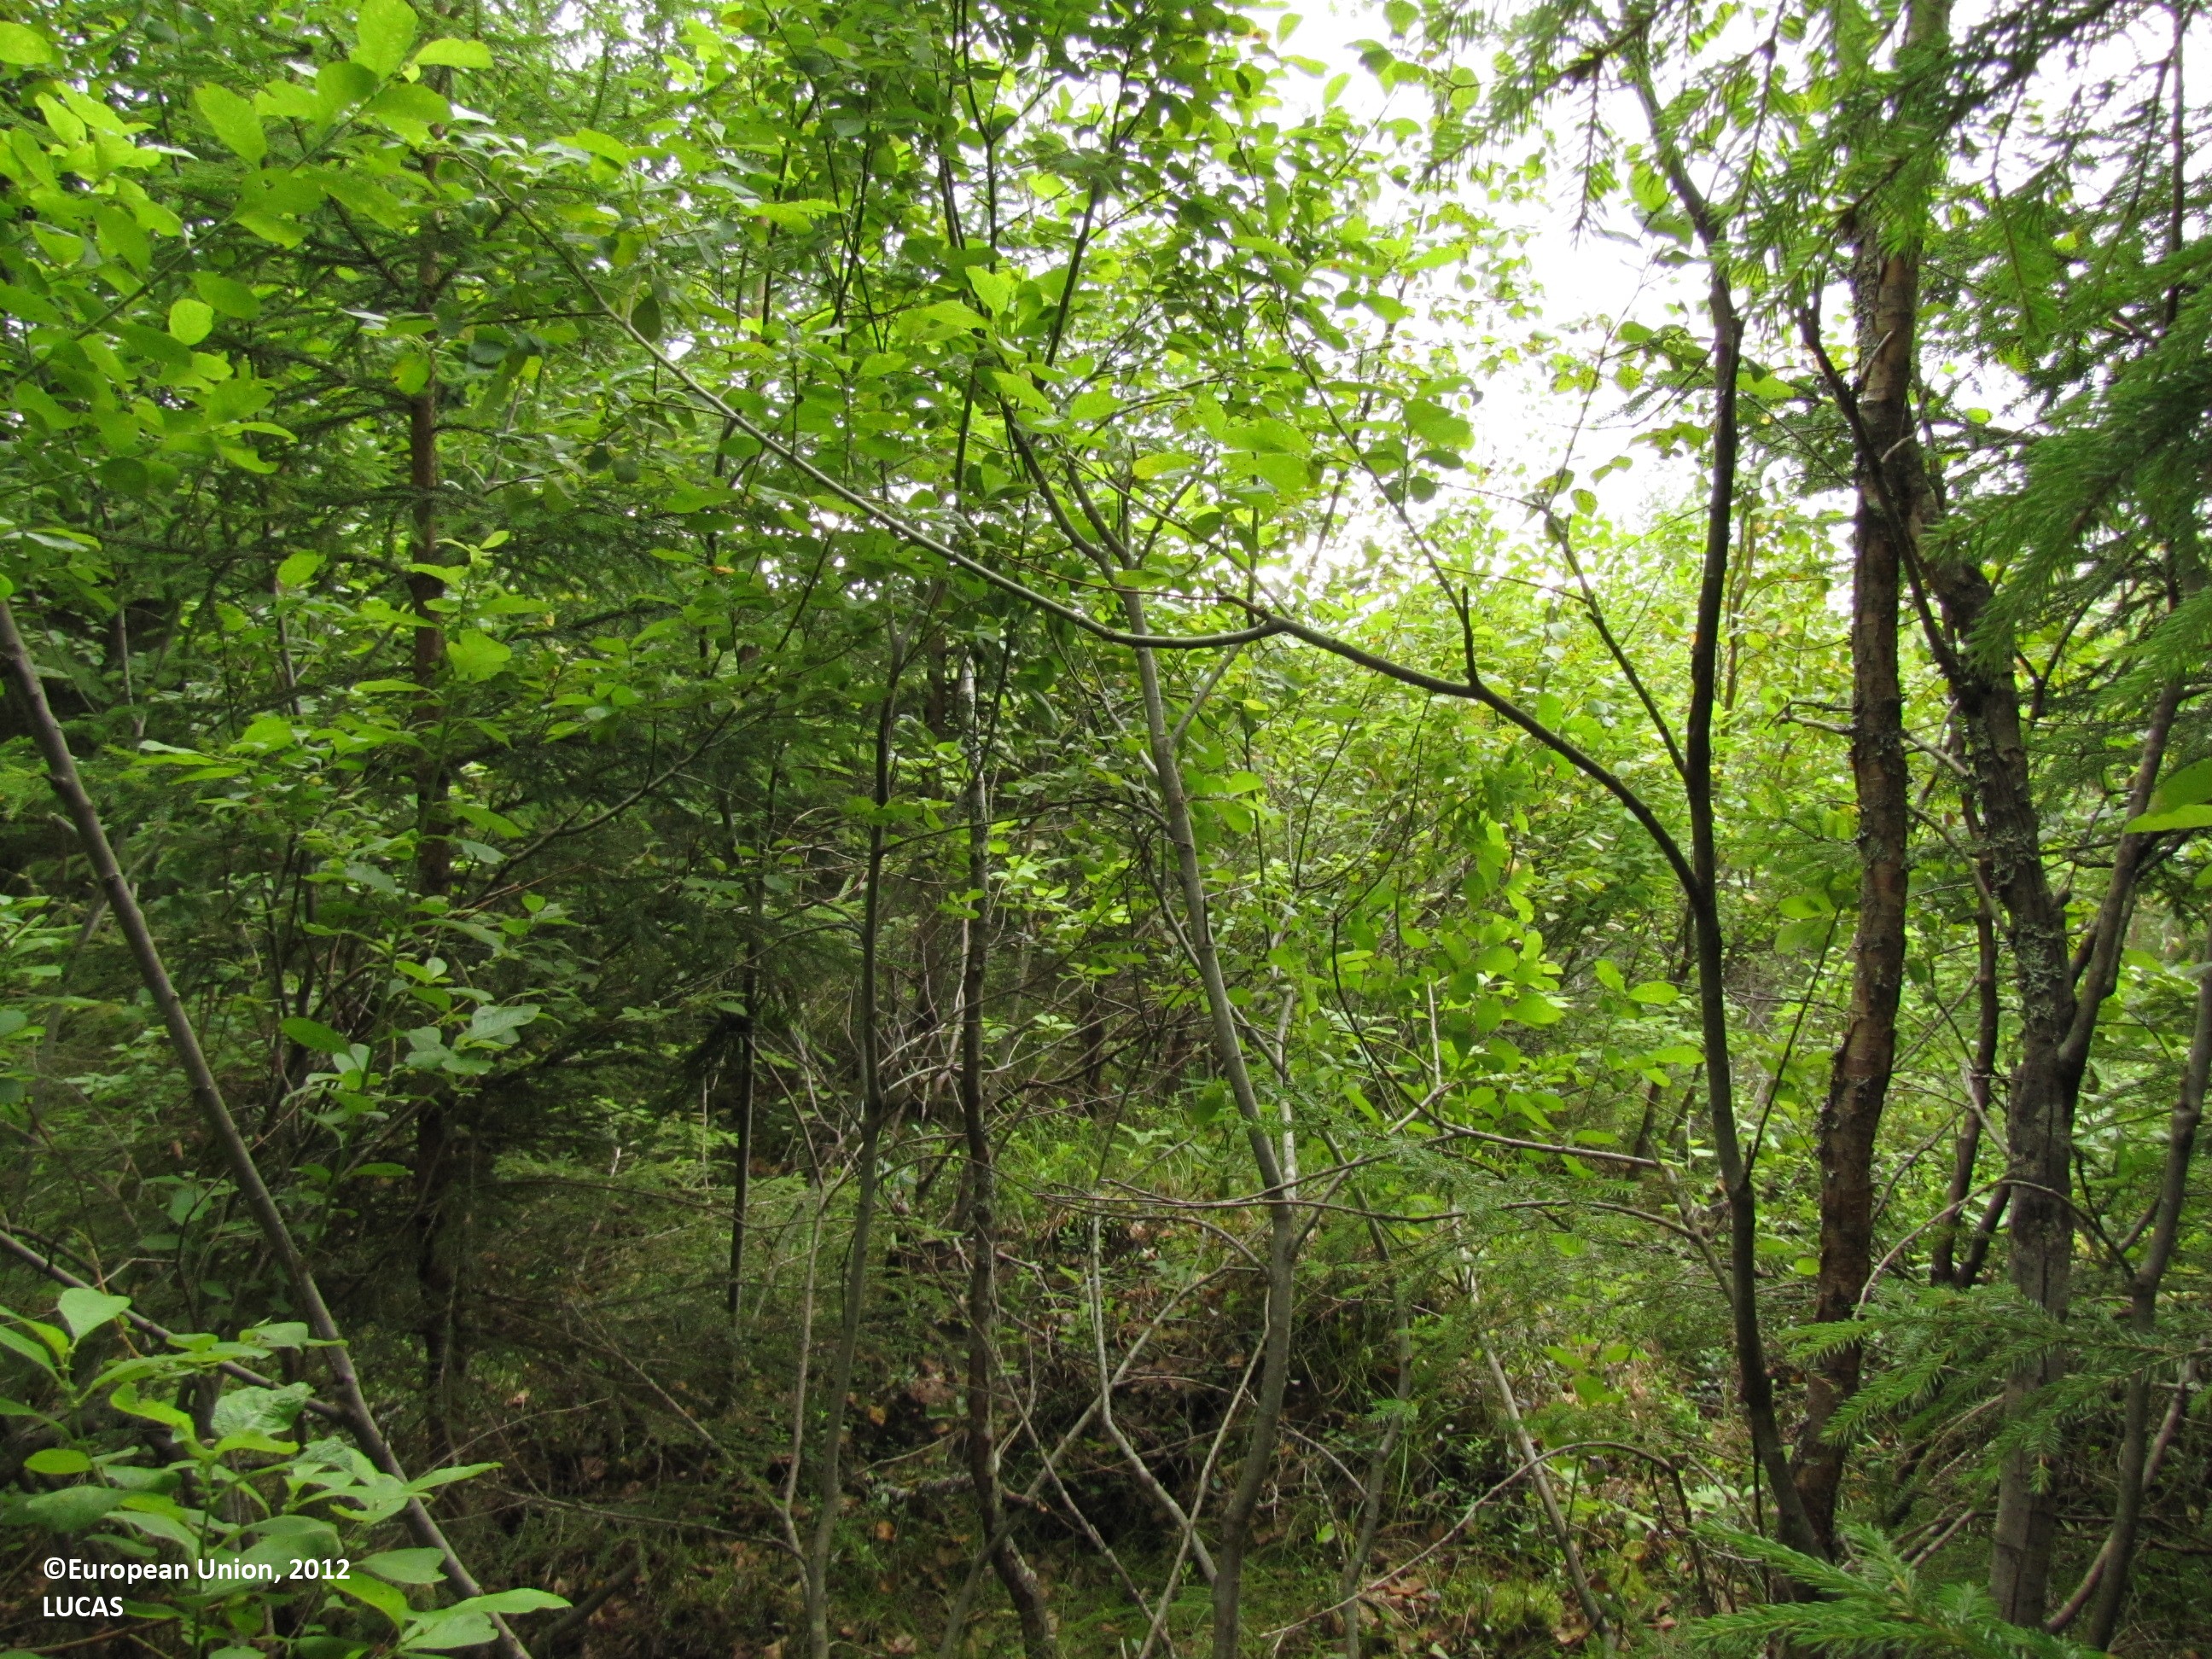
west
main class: Woodland
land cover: Pine dominated mixed woodland
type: boreal forest
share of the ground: 50 - 75 %
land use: Forestry
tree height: > 5 m
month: August
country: FI
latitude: 61.8978
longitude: 23.2213
